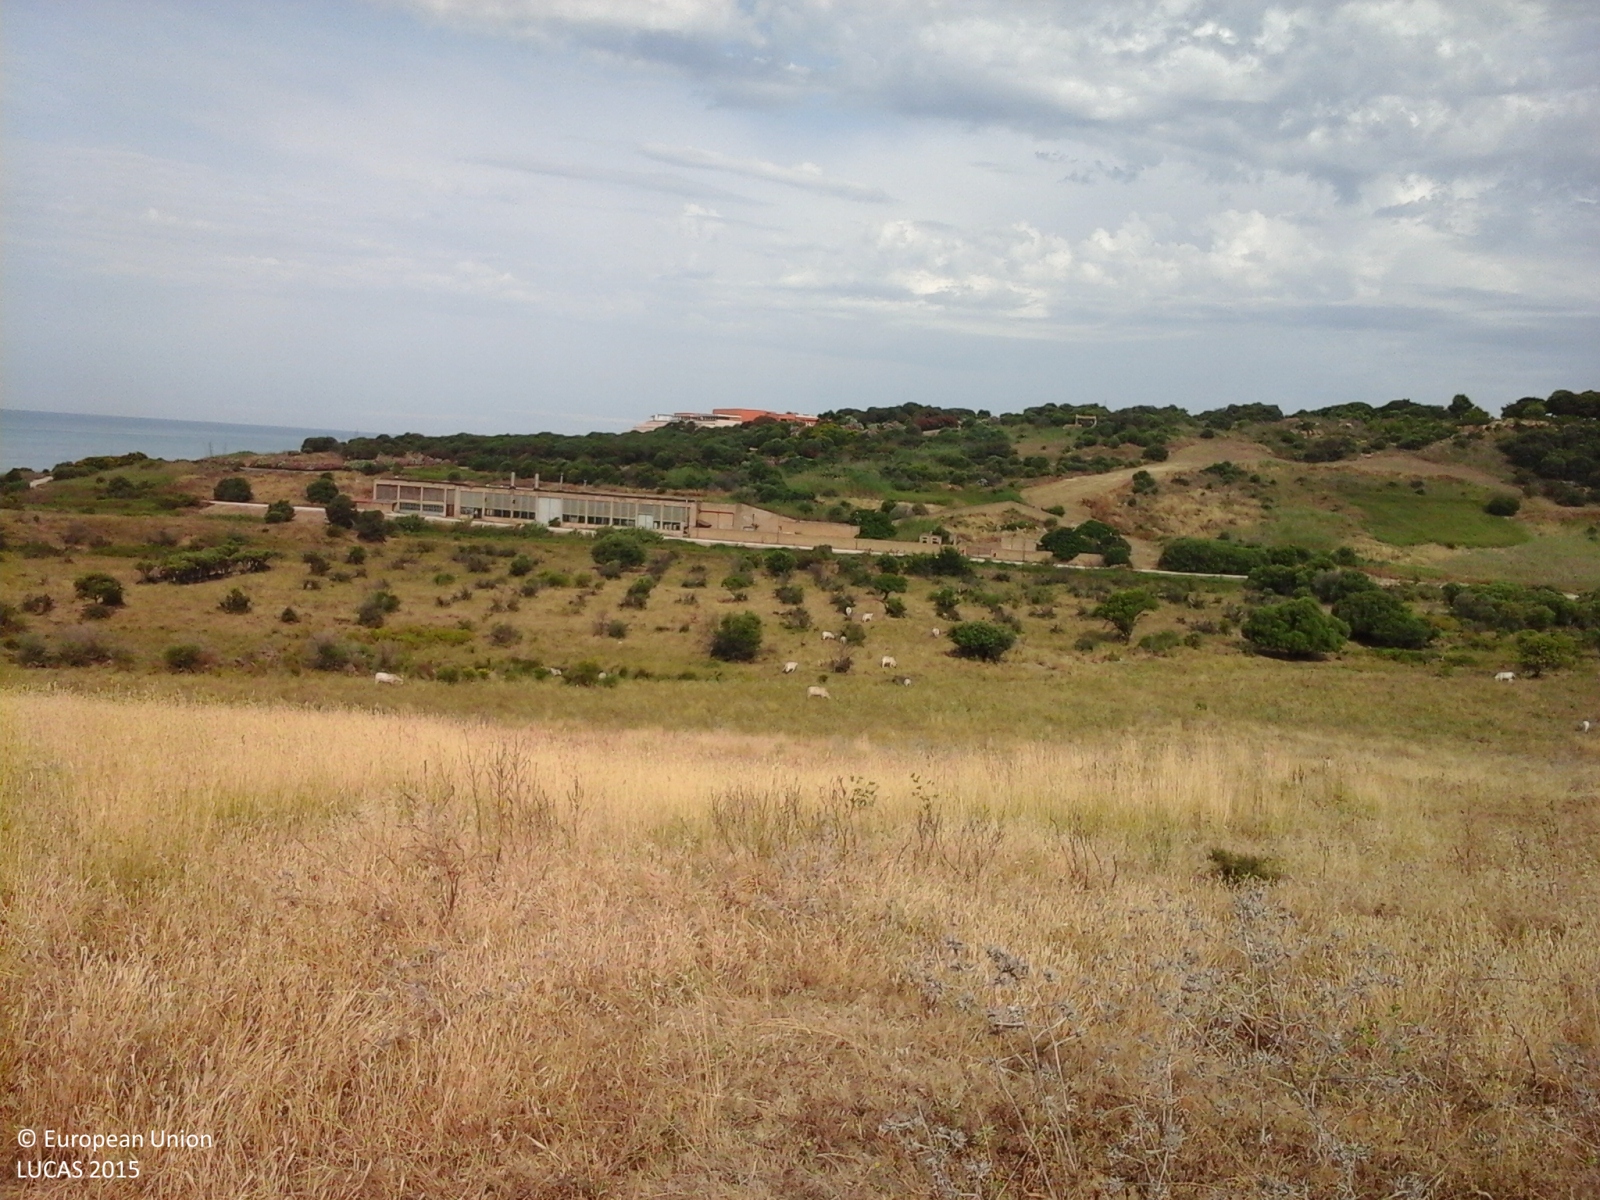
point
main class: Grassland
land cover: Grassland without tree/shrub cover
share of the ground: > 75 %
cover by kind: herbaceous plants 100 %
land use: Agriculture (excluding fallow land and kitchen gardens)
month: June
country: IT
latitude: 37.4961
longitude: 13.1317
